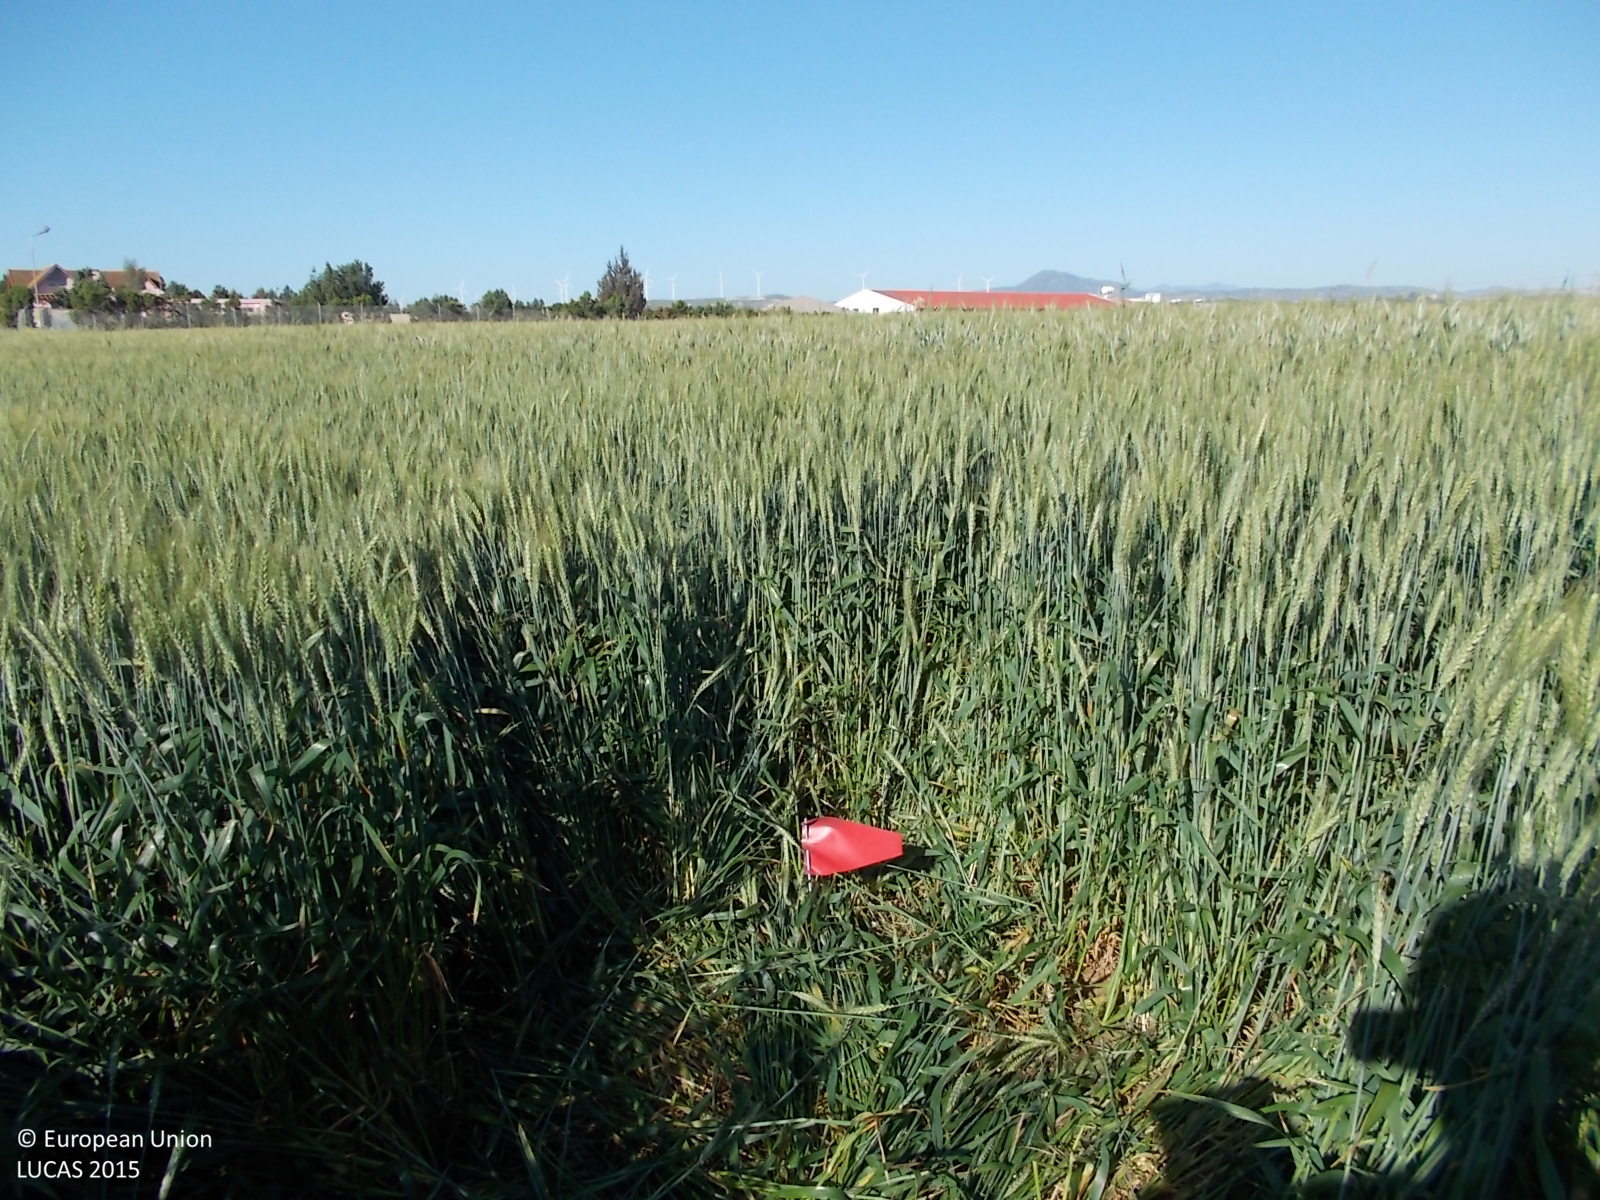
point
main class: Cropland
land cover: Common wheat
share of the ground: > 75 %
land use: Agriculture (excluding fallow land and kitchen gardens)
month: April
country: CY
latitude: 34.8887
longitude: 33.5762
